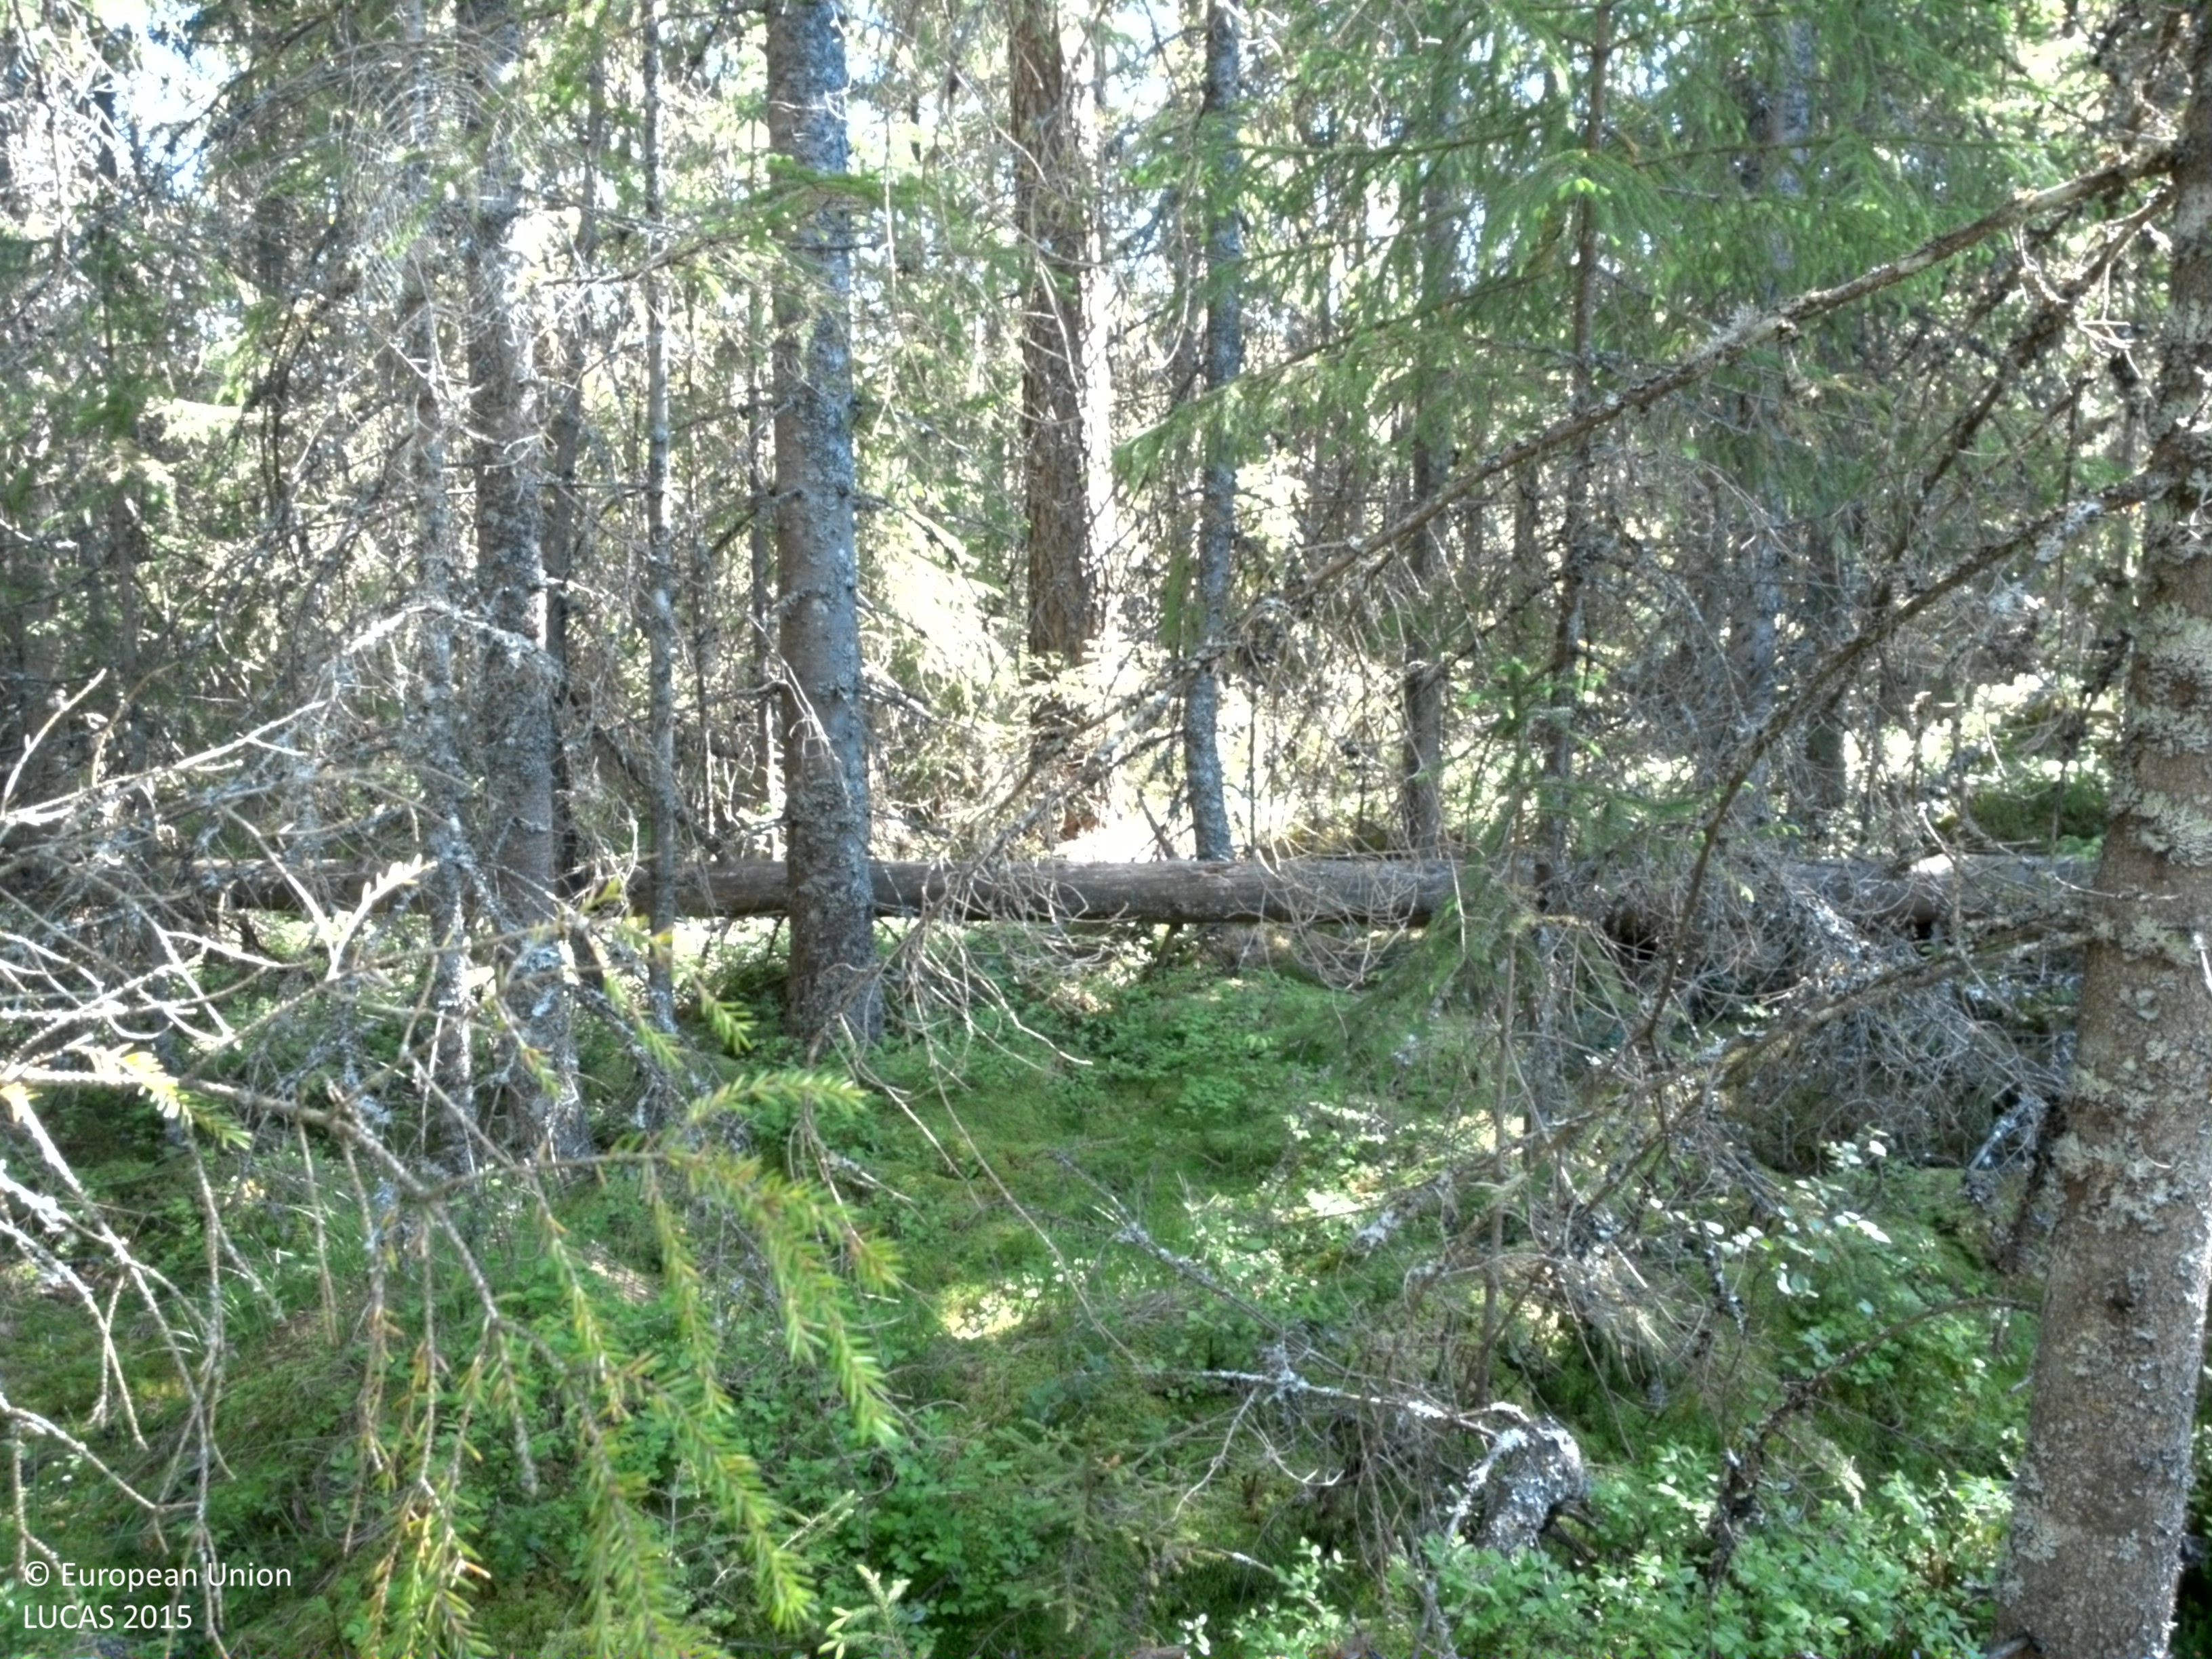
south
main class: Woodland
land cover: Spruce dominated coniferous woodland
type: boreal forest
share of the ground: 50 - 75 %
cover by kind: coniferous forest trees 65 %, shrubs 15 %, herbaceous plants 10 %, broadleaved forest trees 5 %, lichens and mosses 5 %
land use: Forestry
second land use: Community services
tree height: > 5 m
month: June
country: SE
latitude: 59.3096
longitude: 14.6814
